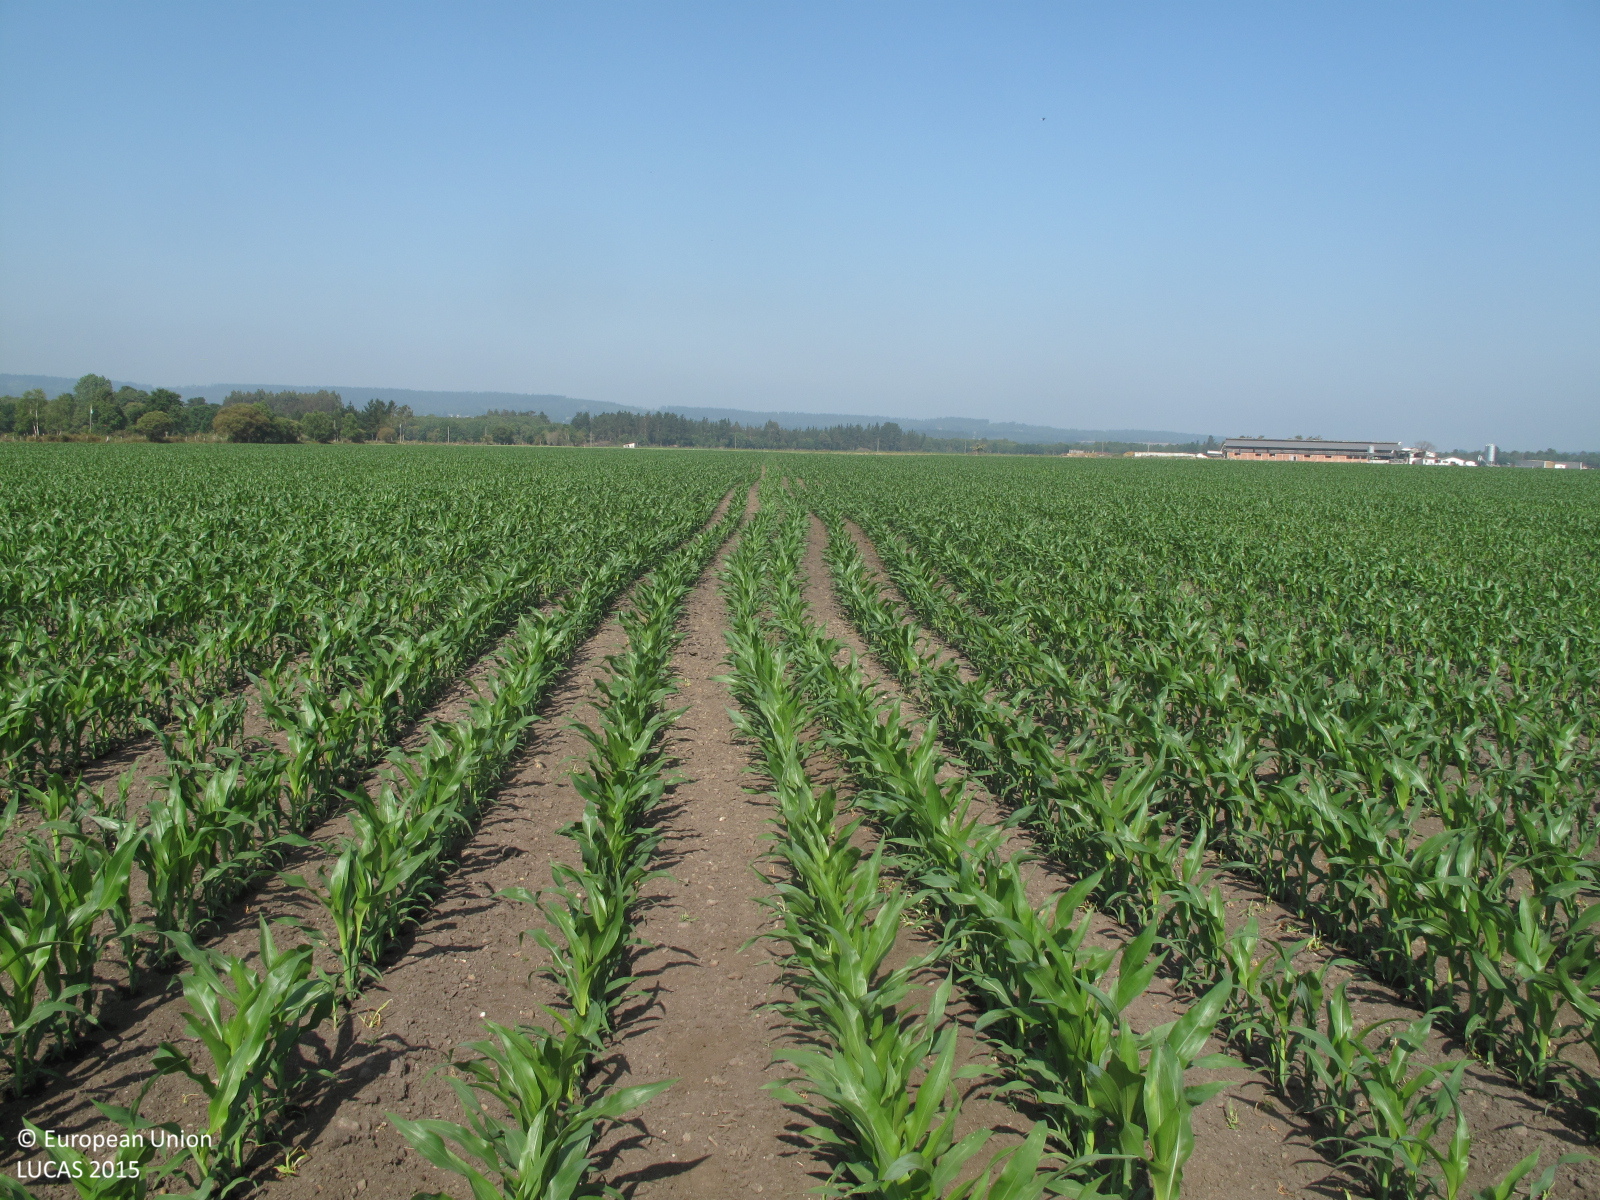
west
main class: Cropland
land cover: Maize
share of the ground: 25 - 50 %
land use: Agriculture (excluding fallow land and kitchen gardens)
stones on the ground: < 10 %
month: June
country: ES
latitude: 43.1680
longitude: -7.8872
